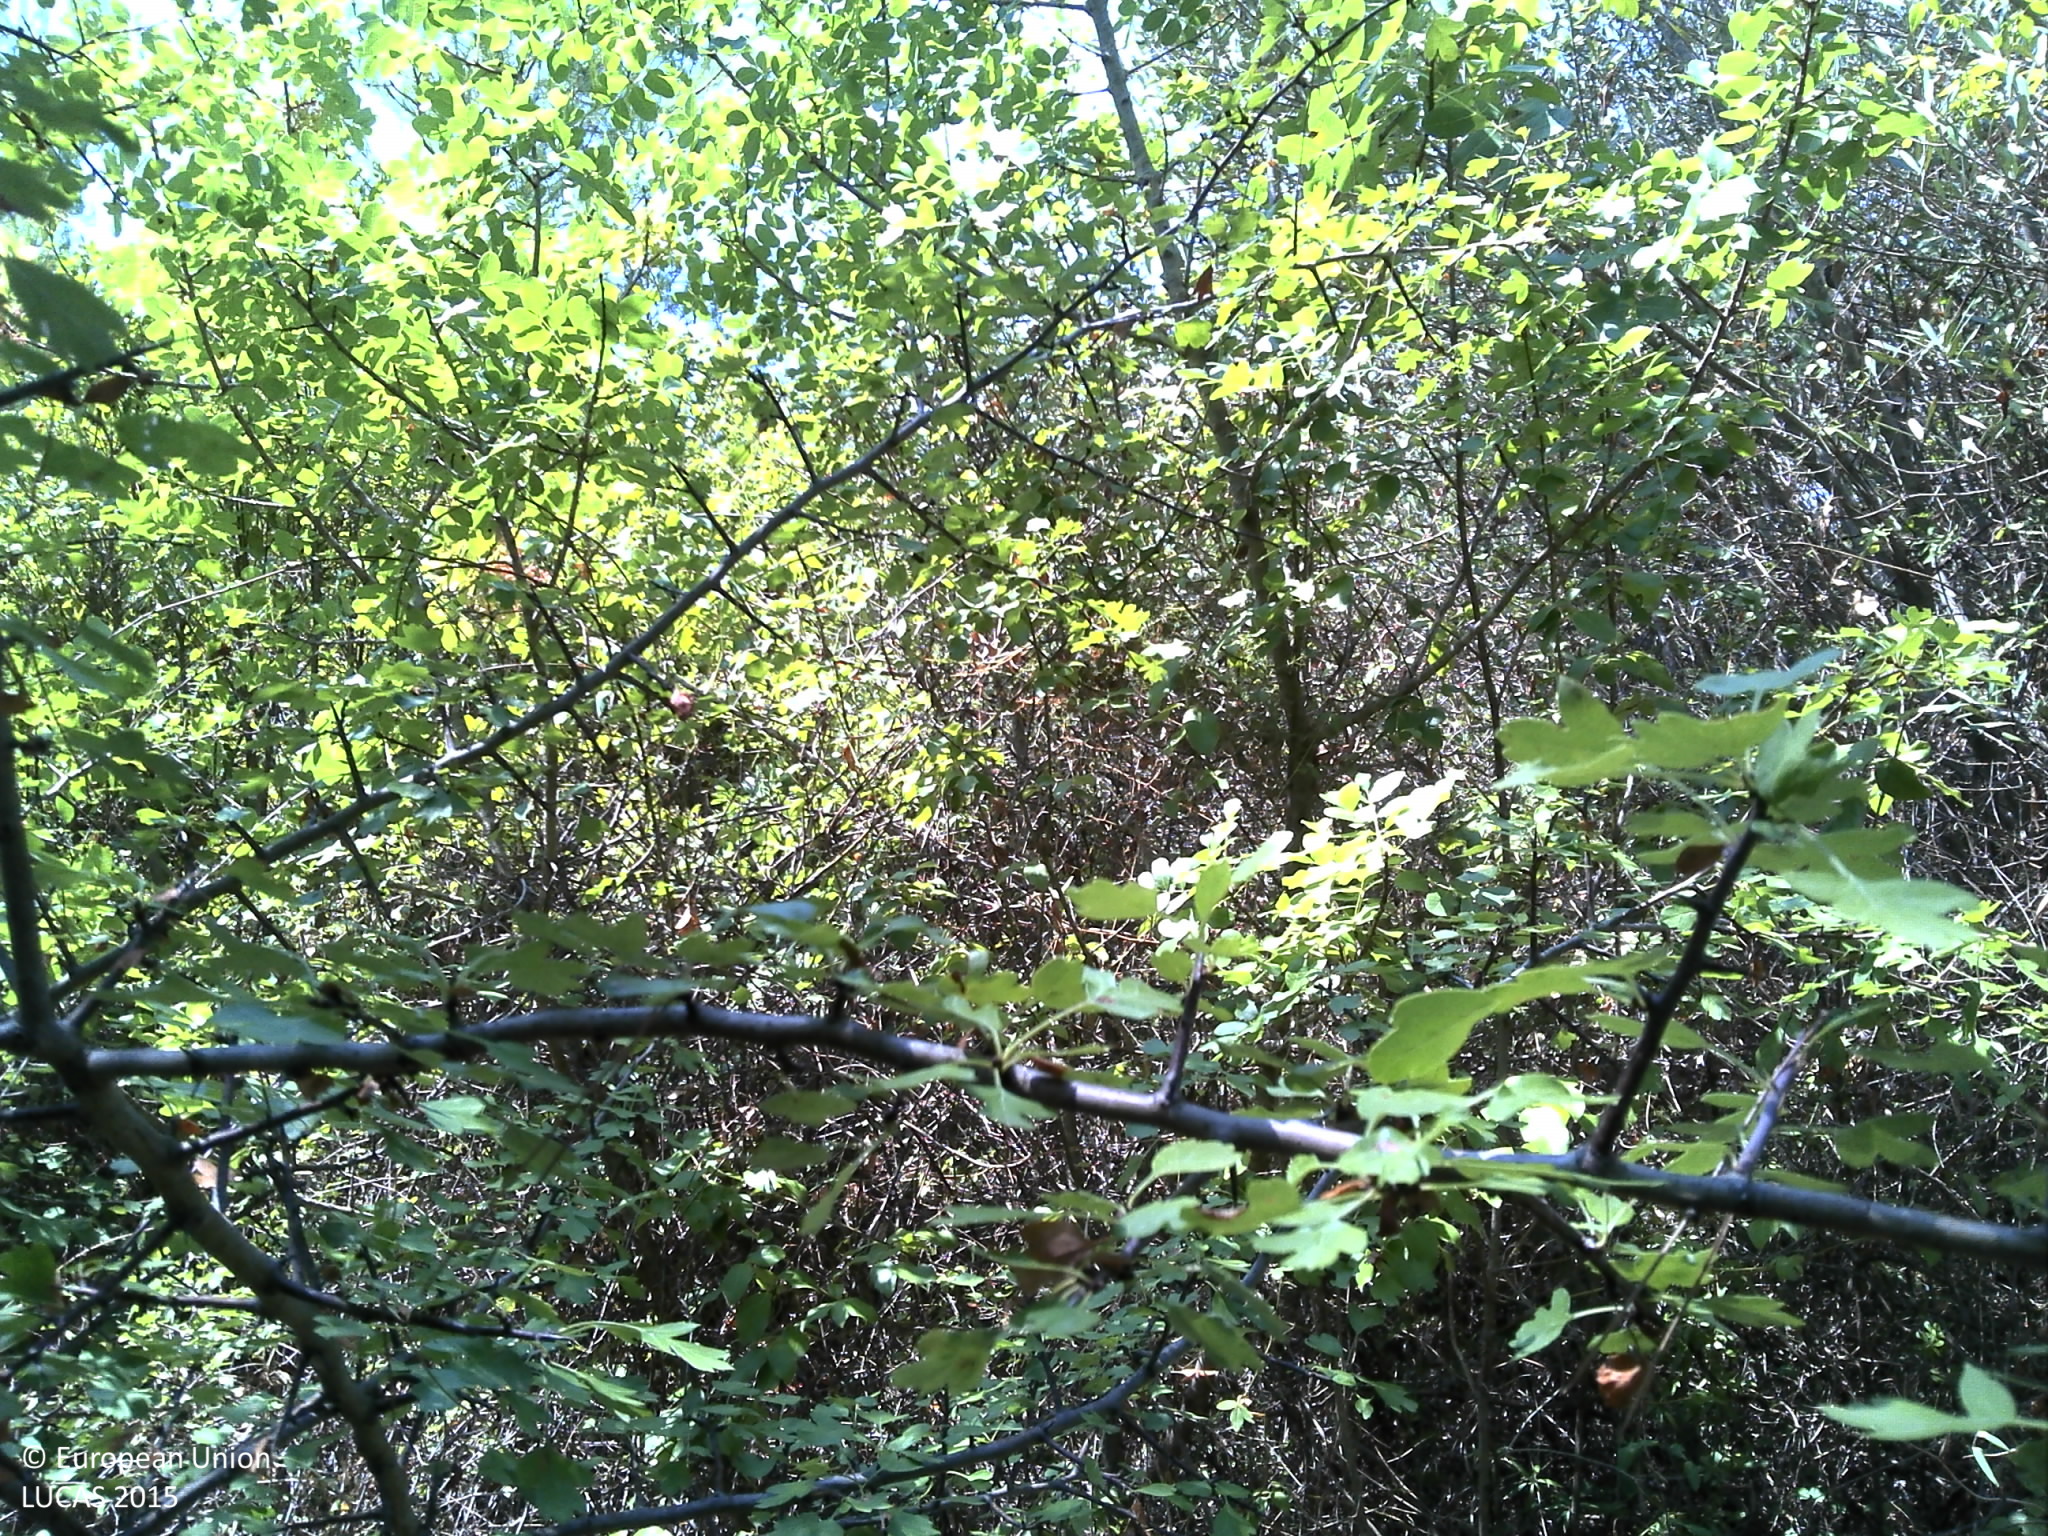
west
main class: Woodland
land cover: Other mixed woodland
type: coniferous forest of the mediterranean region
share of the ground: > 75 %
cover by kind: shrubs 45 %, coniferous forest trees 30 %, broadleaved forest trees 25 %
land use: Semi-natural and natural areas not in use
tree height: > 5 m
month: August
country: HR
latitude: 42.9121
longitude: 16.8360
